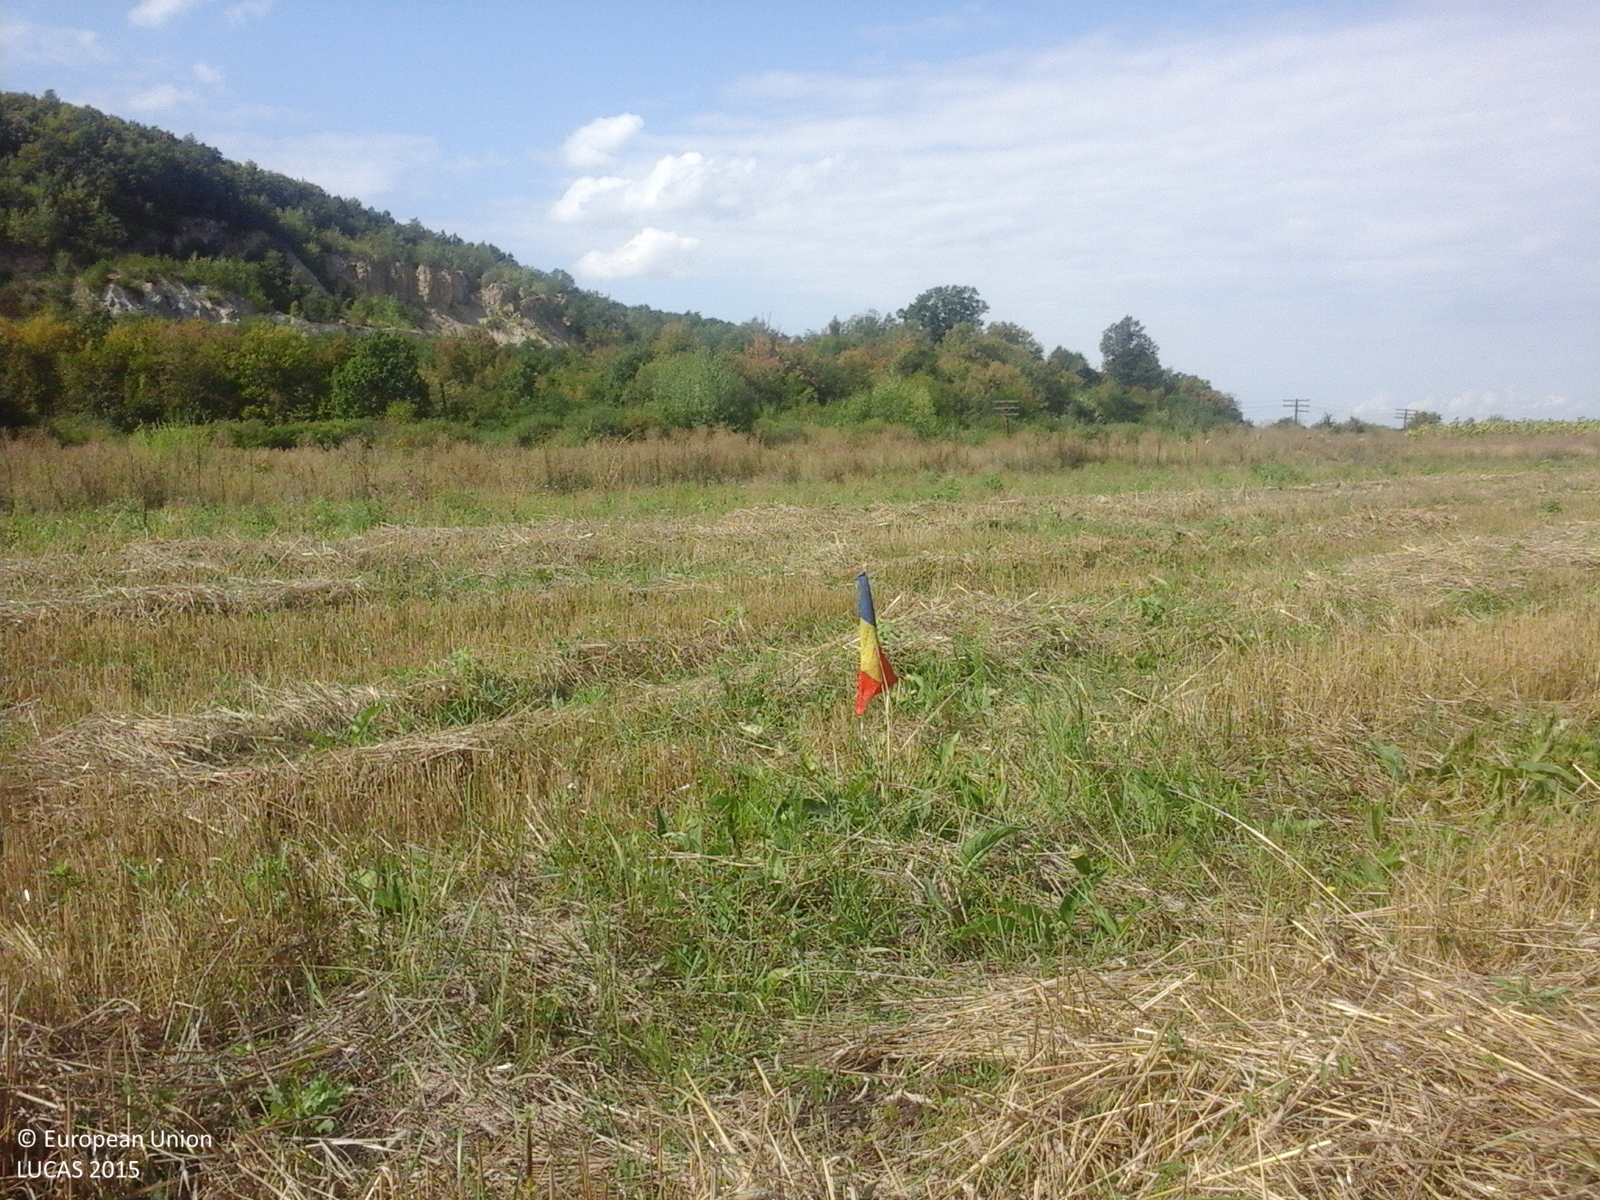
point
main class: Cropland
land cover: Common wheat
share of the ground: > 75 %
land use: Agriculture (excluding fallow land and kitchen gardens)
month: September
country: RO
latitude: 47.8554
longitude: 23.2632
